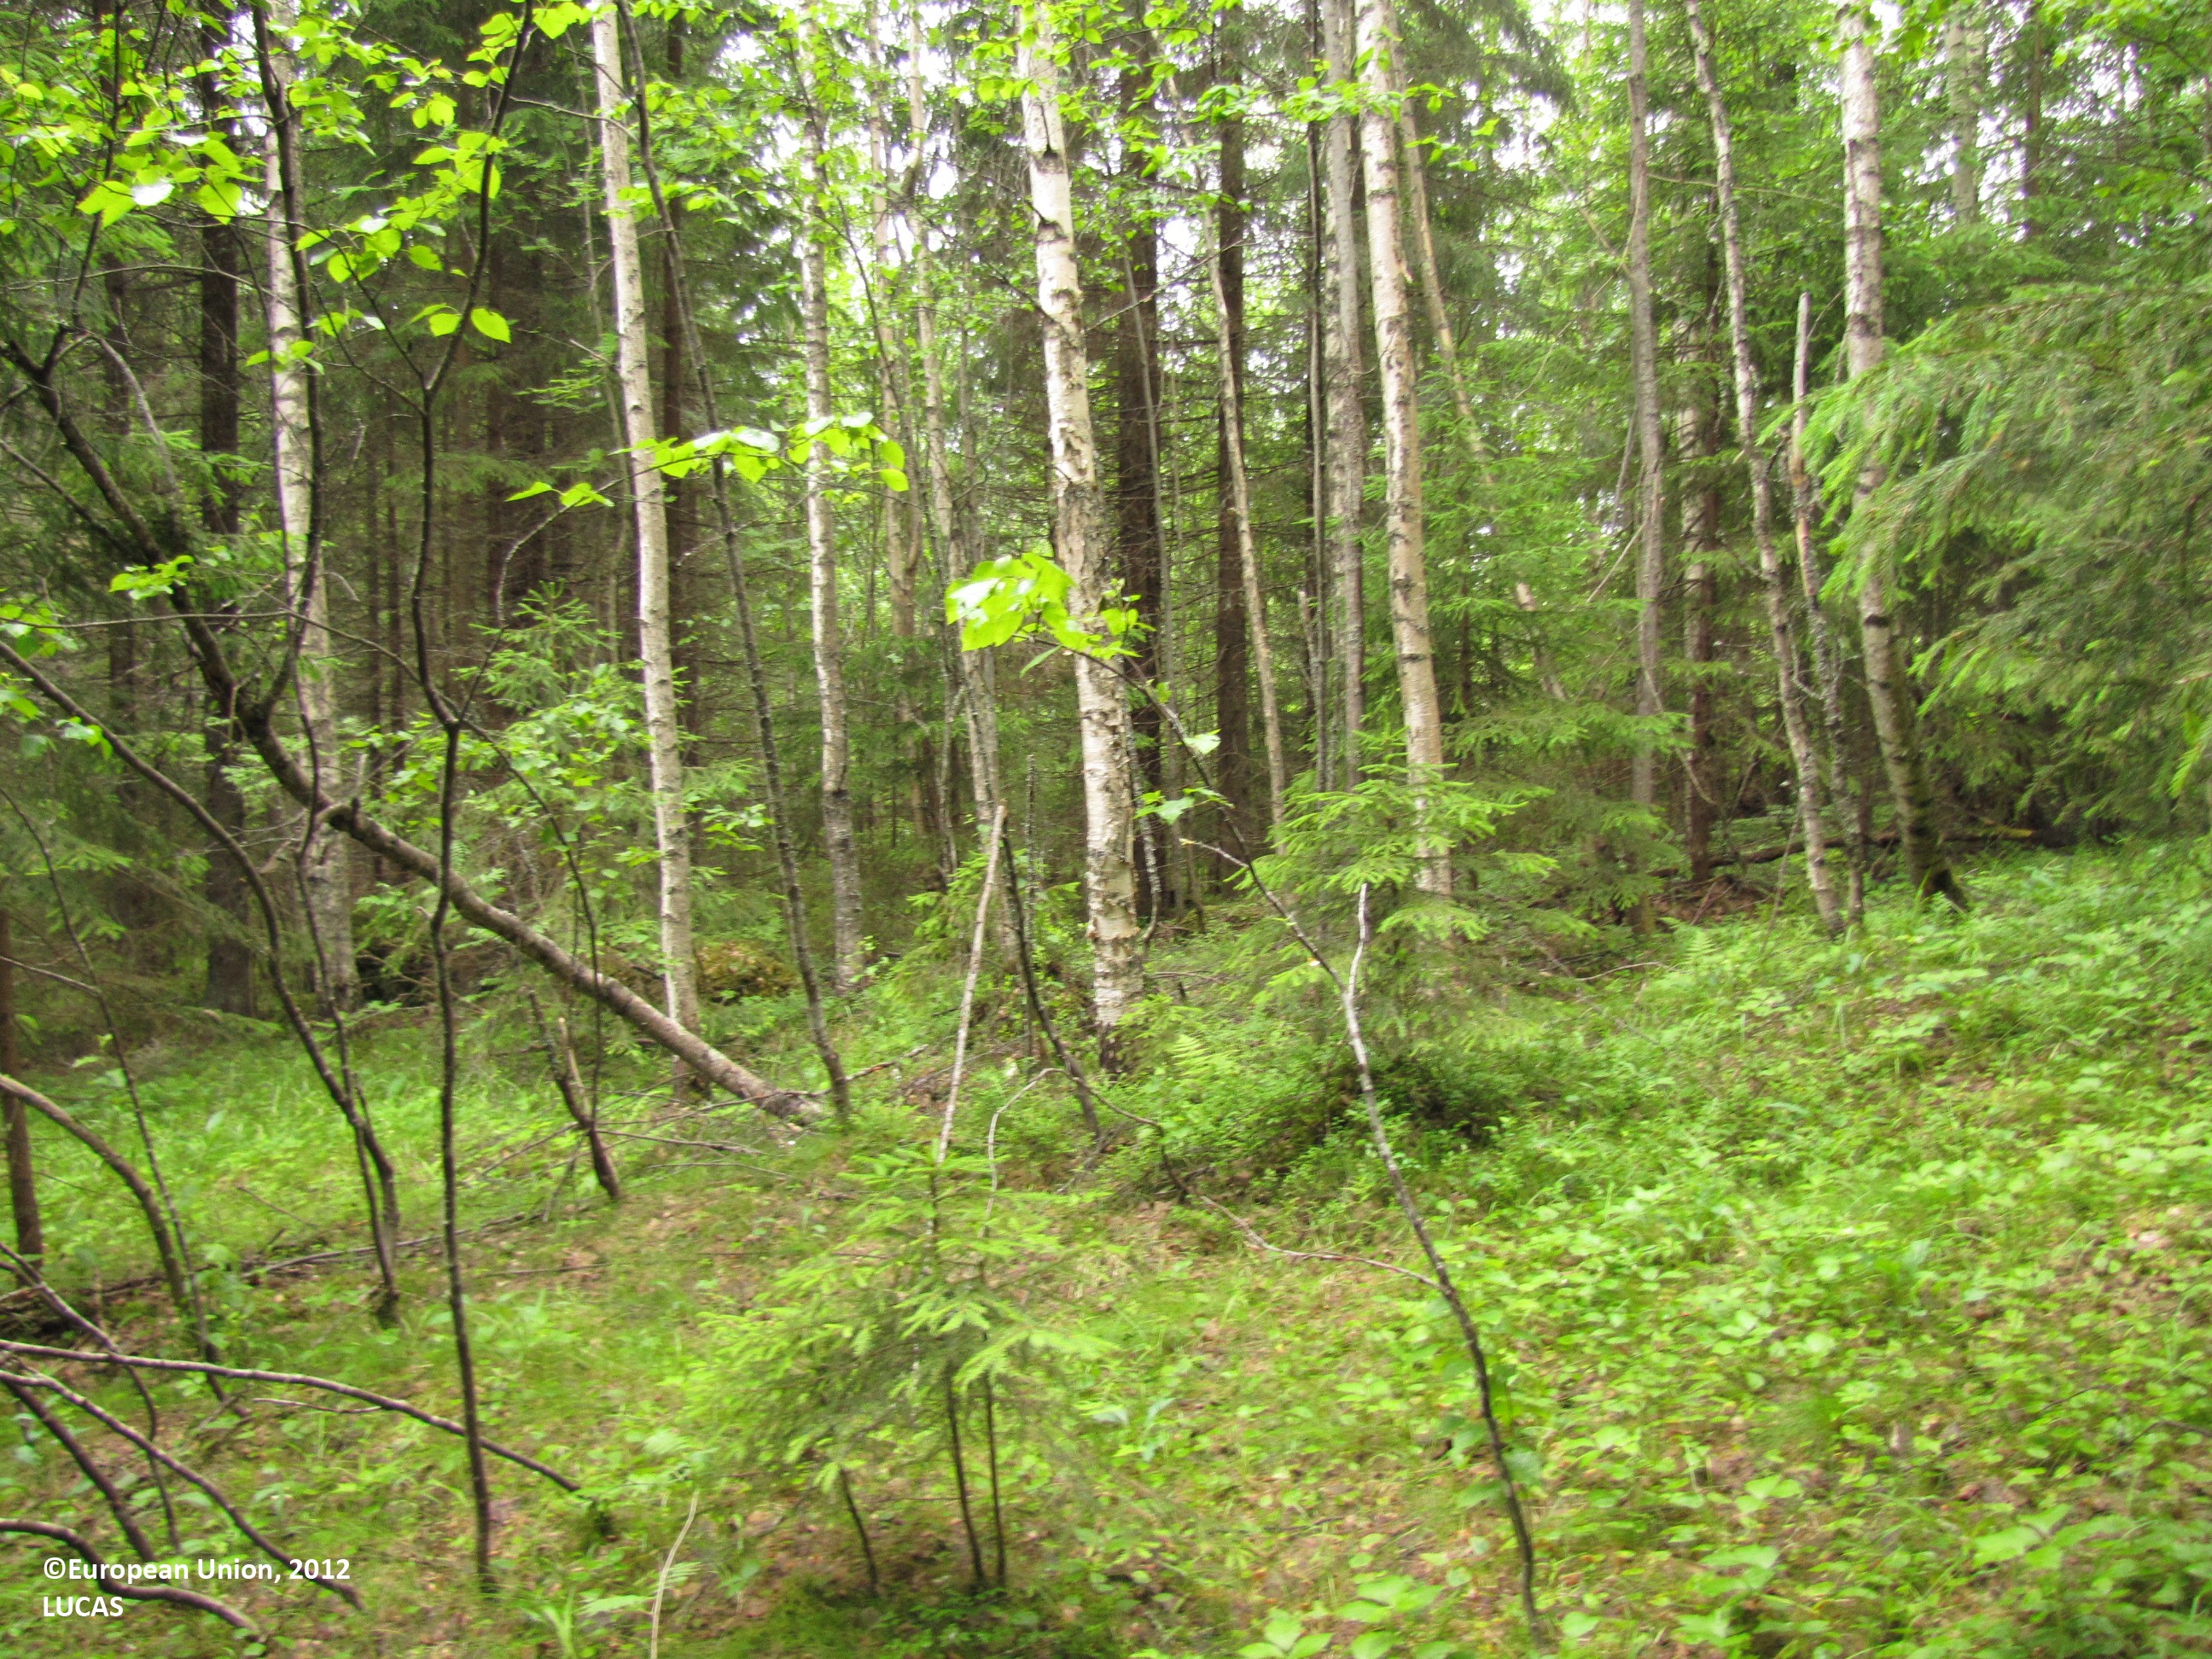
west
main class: Woodland
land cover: Spruce dominated coniferous woodland
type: boreal forest
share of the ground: > 75 %
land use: Forestry
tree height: > 5 m
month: June
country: FI
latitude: 61.7707
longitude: 24.5575
